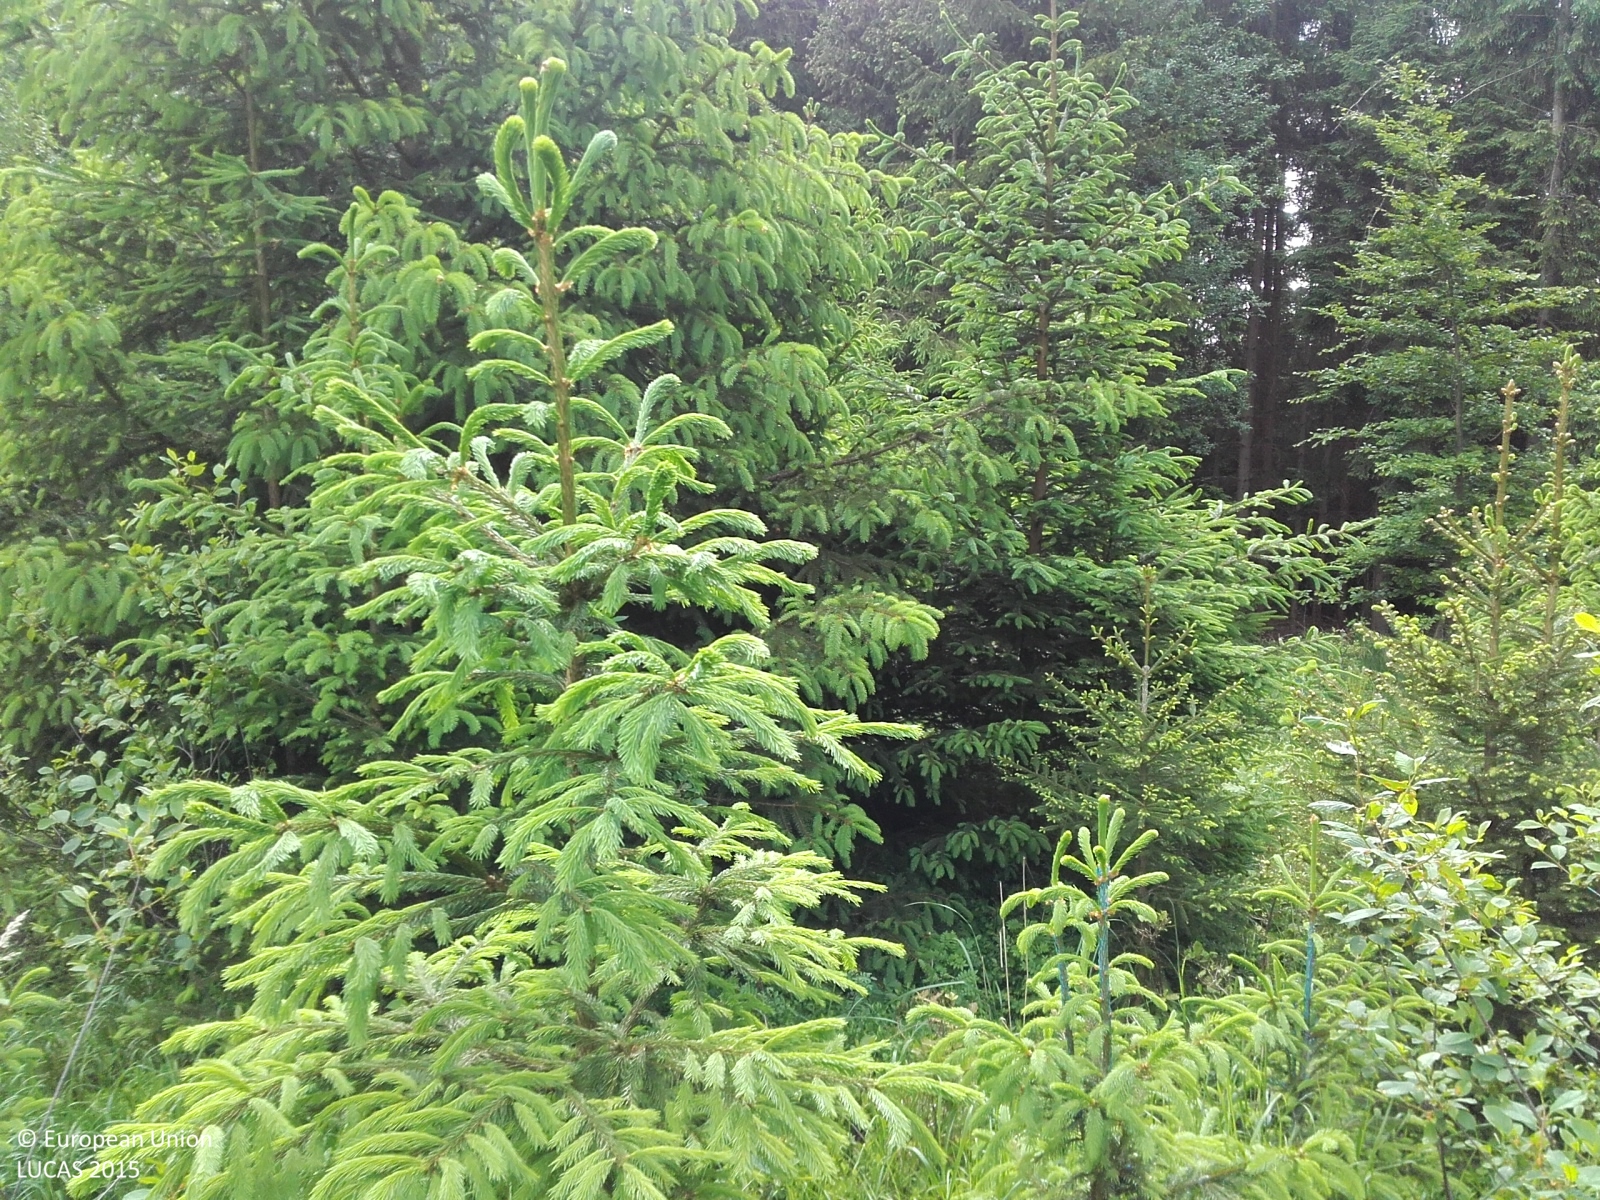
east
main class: Woodland
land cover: Spruce dominated mixed woodland
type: hemiboreal forest and nemoral coniferous forest and mixed broadleaved-coniferous forest
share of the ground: > 75 %
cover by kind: coniferous forest trees 60 %, broadleaved forest trees 20 %, shrubs 10 %, herbaceous plants 10 %
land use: Forestry
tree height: > 5 m
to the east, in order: Spruce dominated mixed woodland; Spruce dominated coniferous woodland; Spruce dominated mixed woodland; Grassland without tree/shrub cover
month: June
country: CZ
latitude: 49.6206
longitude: 17.6399
